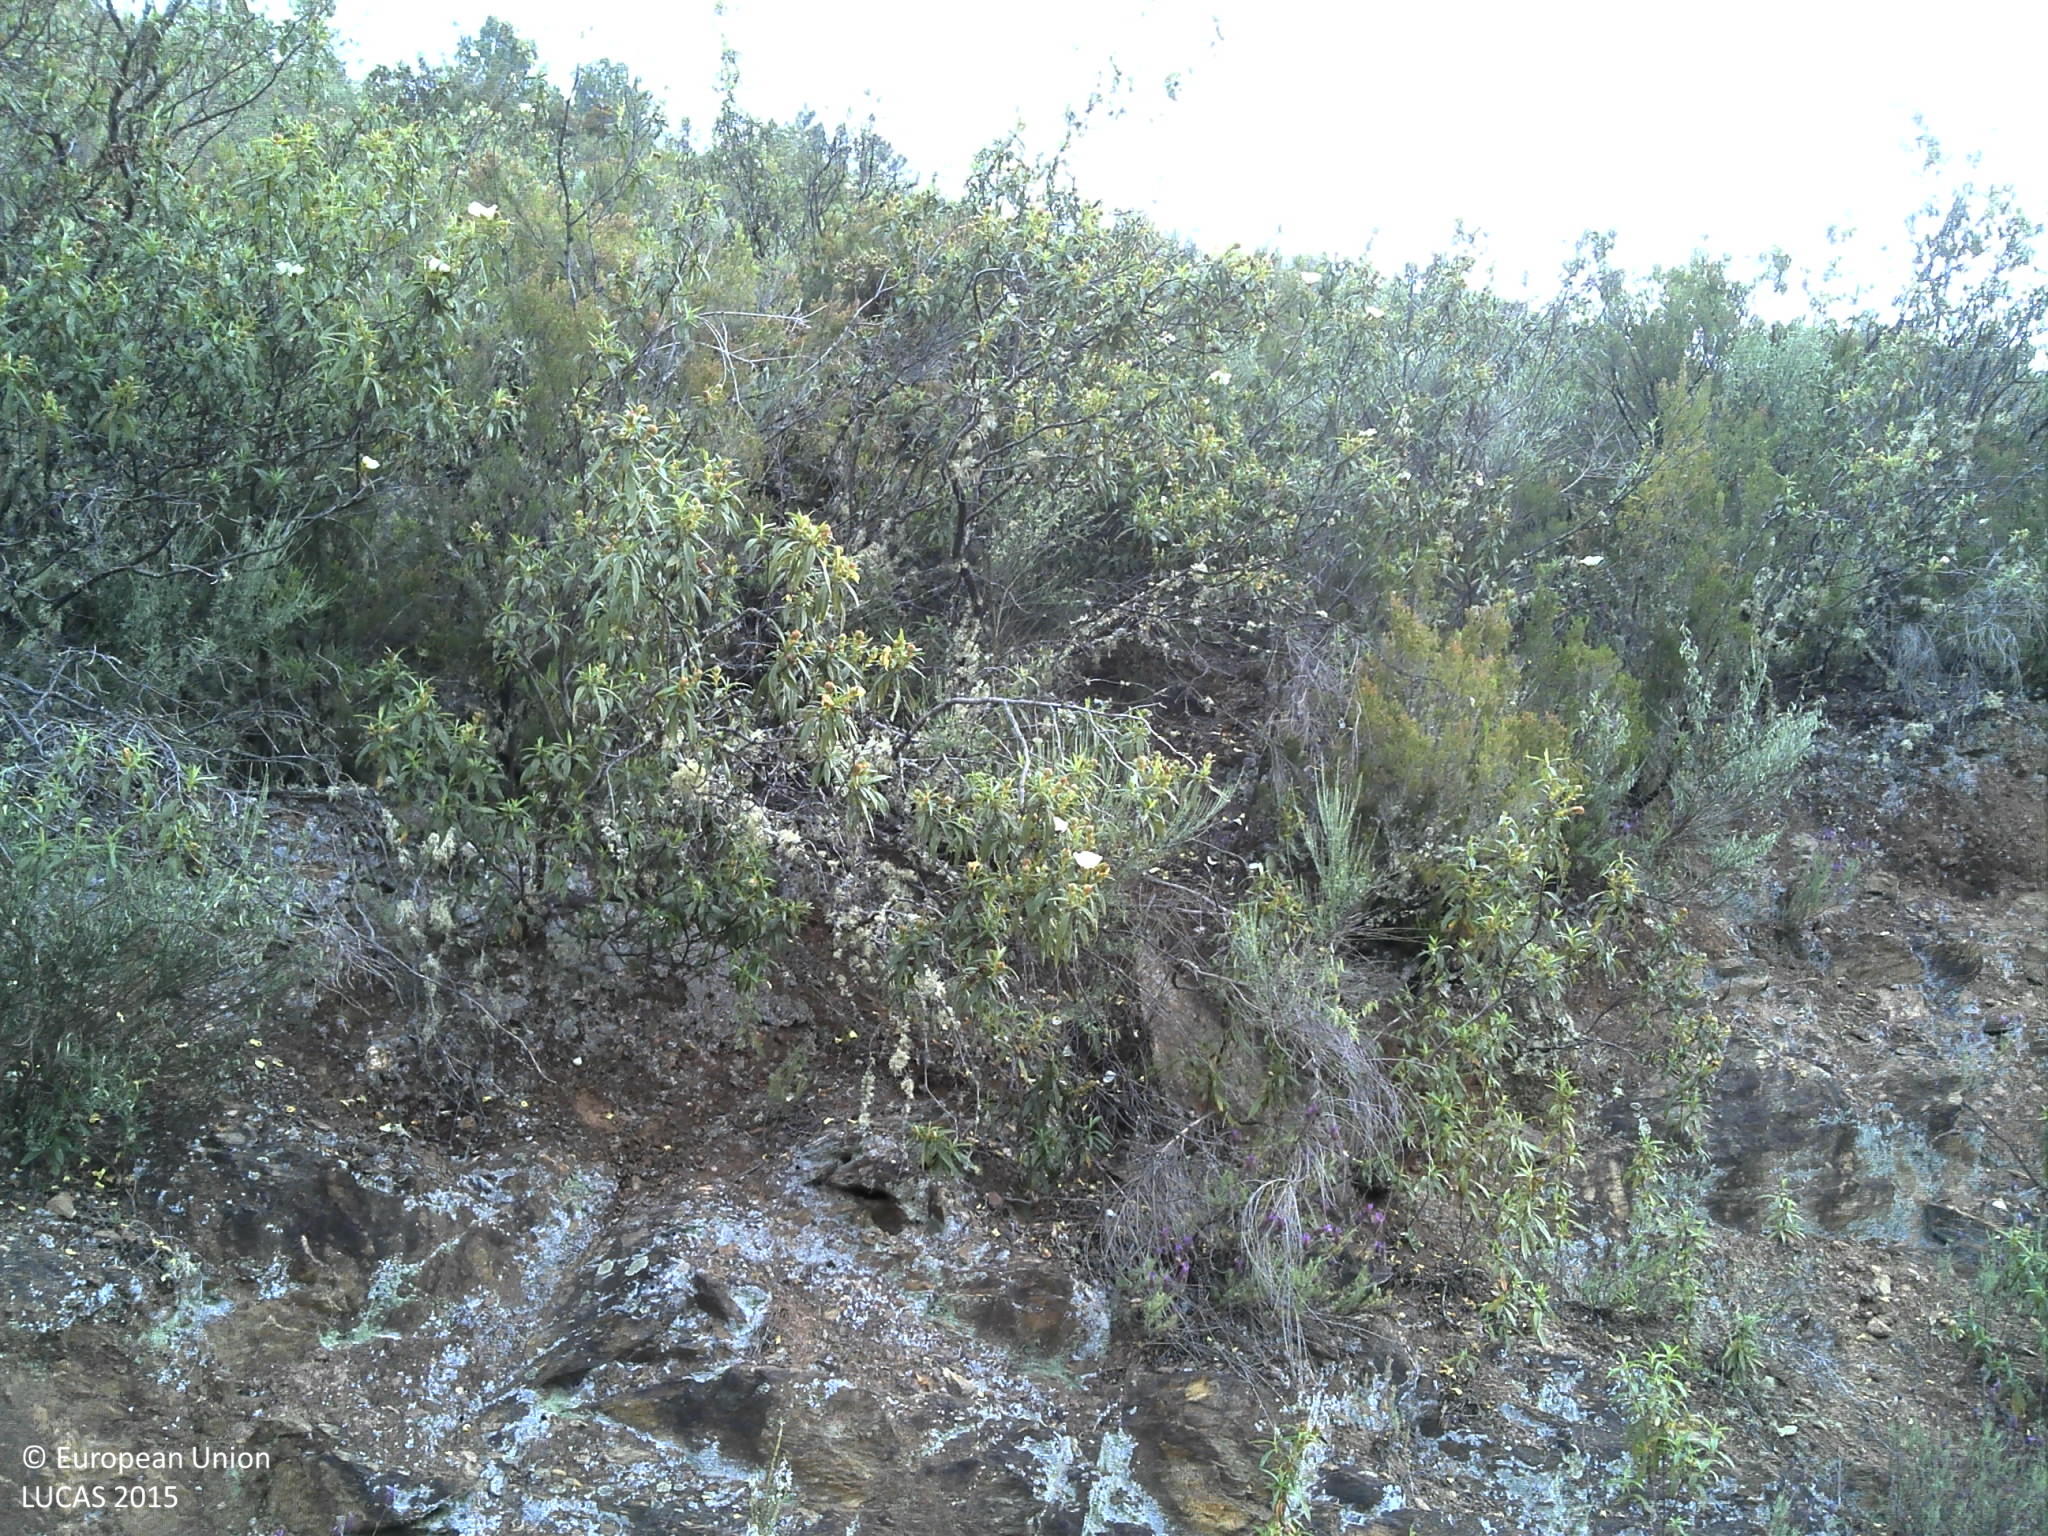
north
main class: Shrubland
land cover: Shrubland without tree cover
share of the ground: > 75 %
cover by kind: shrubs 90 %, unconsolidated bare surface 10 %
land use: Abandoned areas
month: May
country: PT
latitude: 41.7934
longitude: -7.0026
